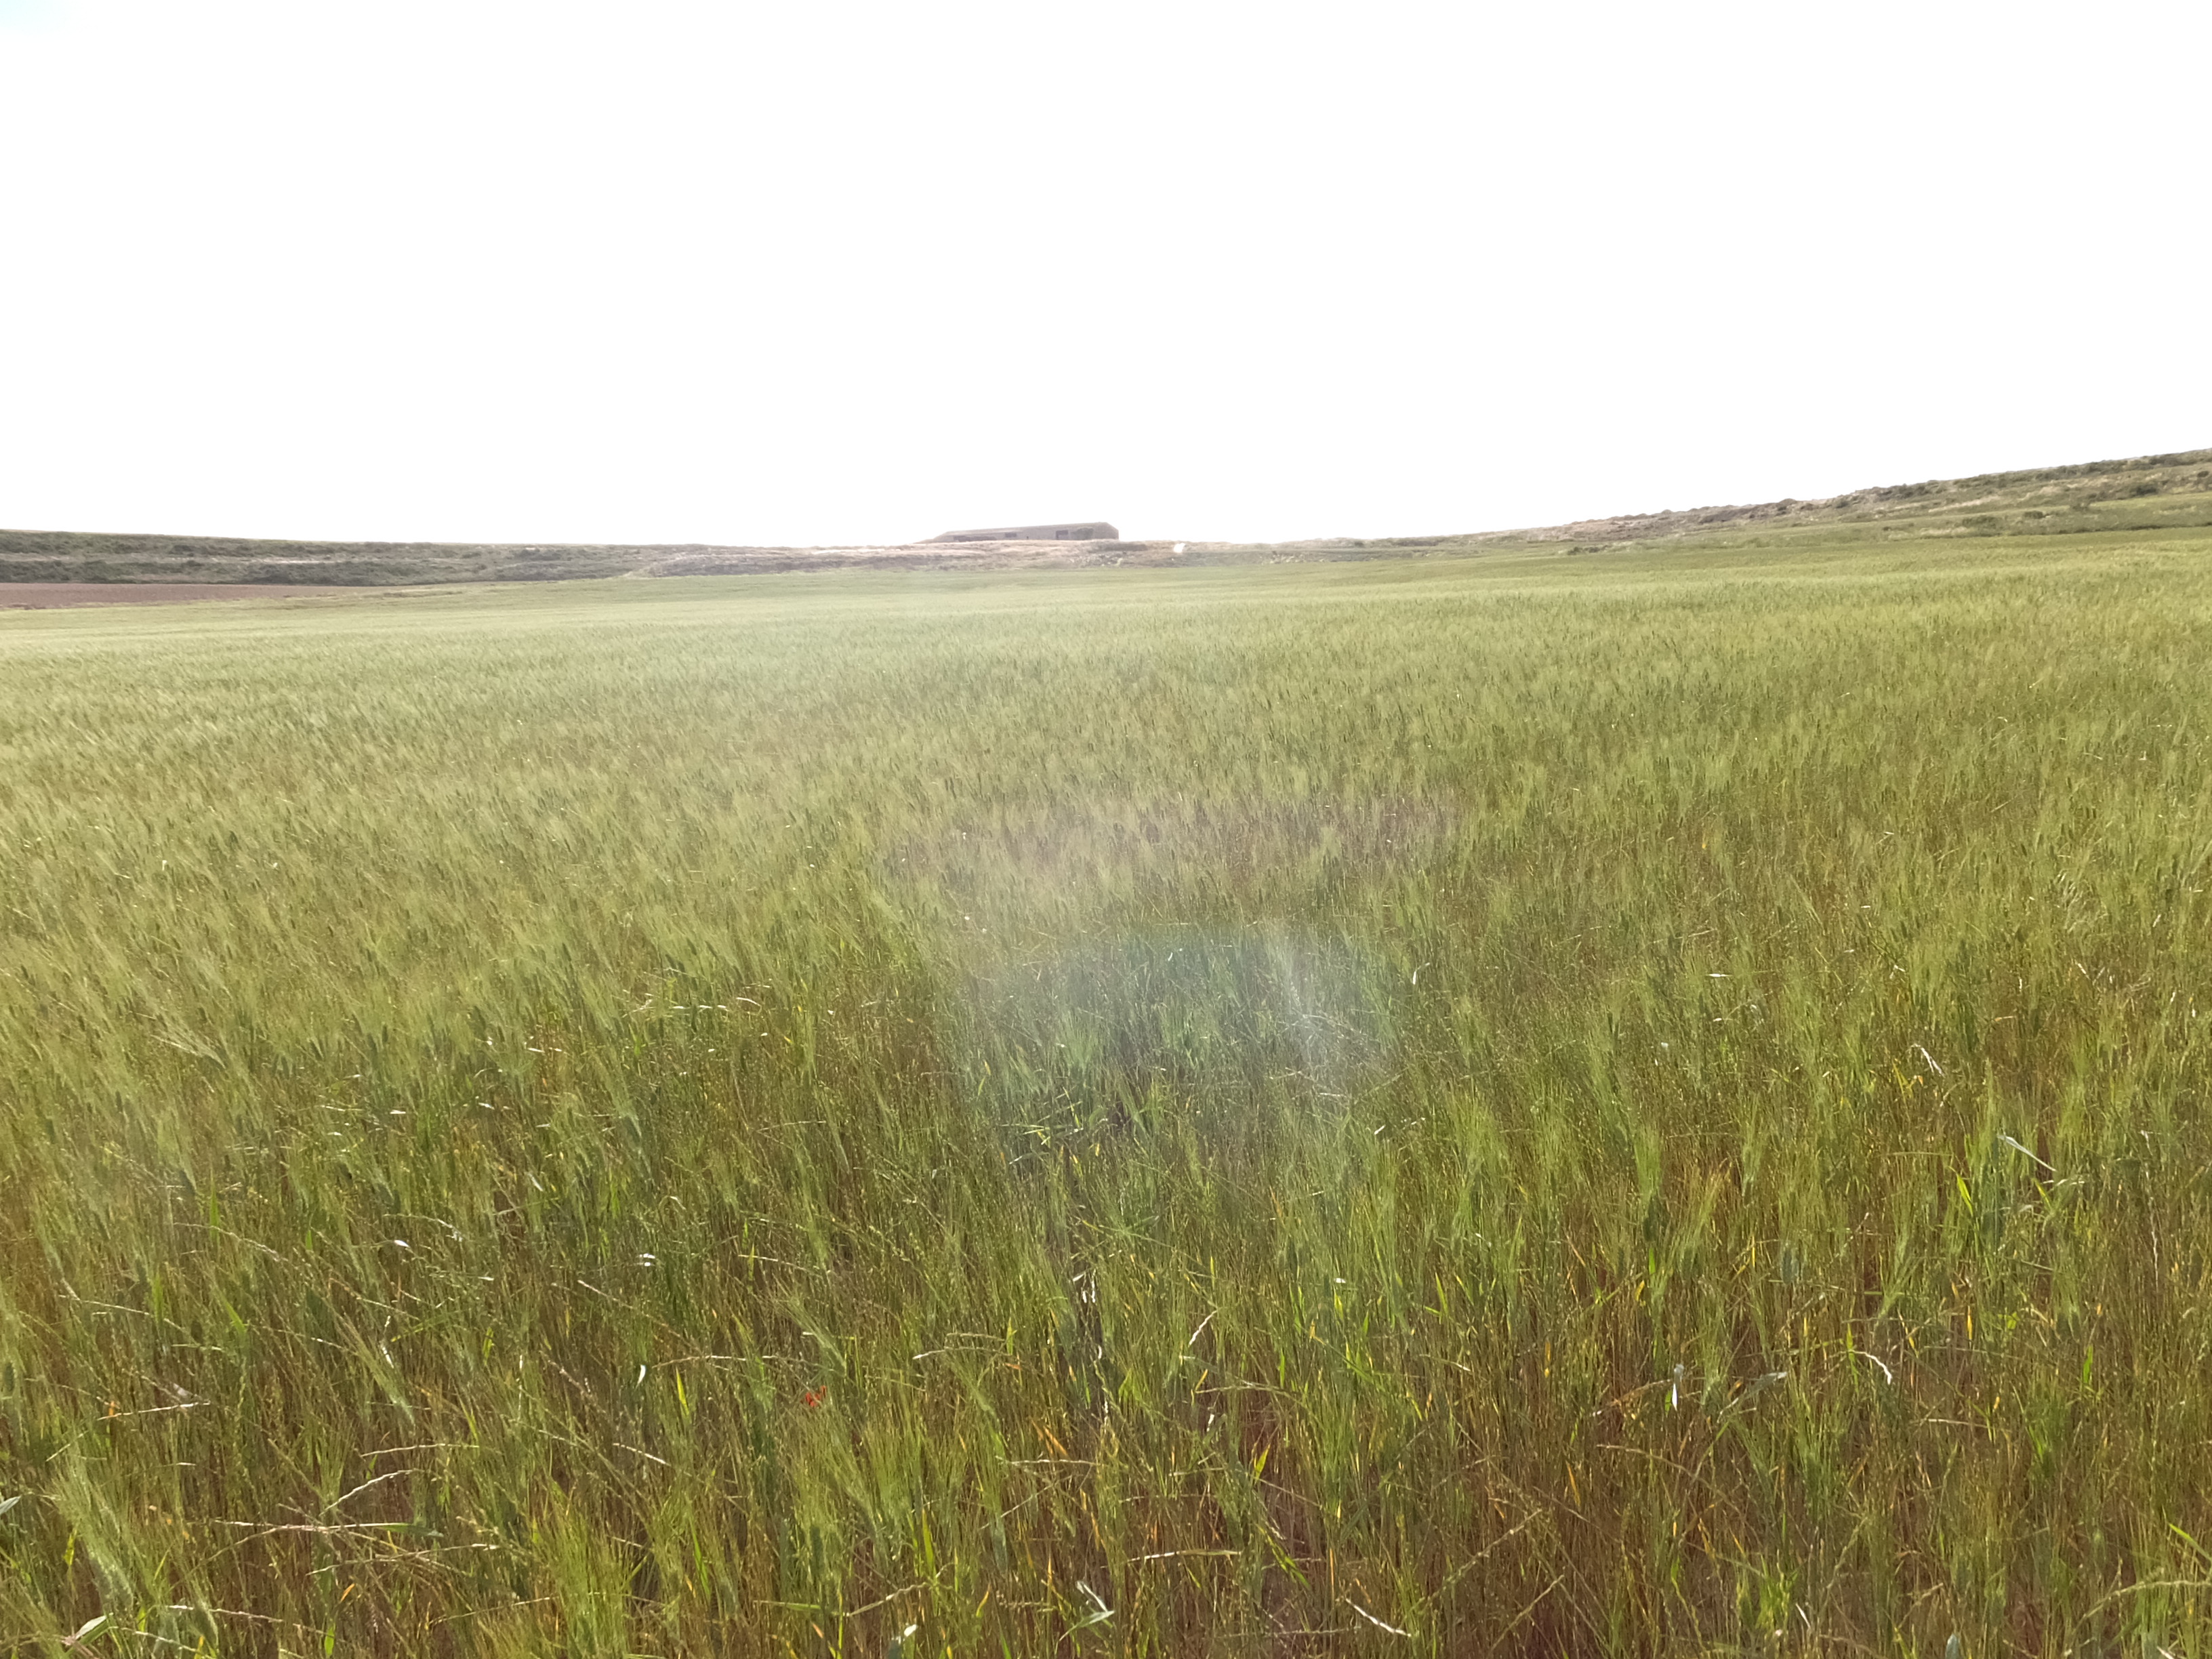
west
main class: Cropland
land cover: Durum wheat
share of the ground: > 75 %
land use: Agriculture (excluding fallow land and kitchen gardens)
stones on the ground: < 10 %
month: May
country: ES
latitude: 41.3698
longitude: -0.2368
